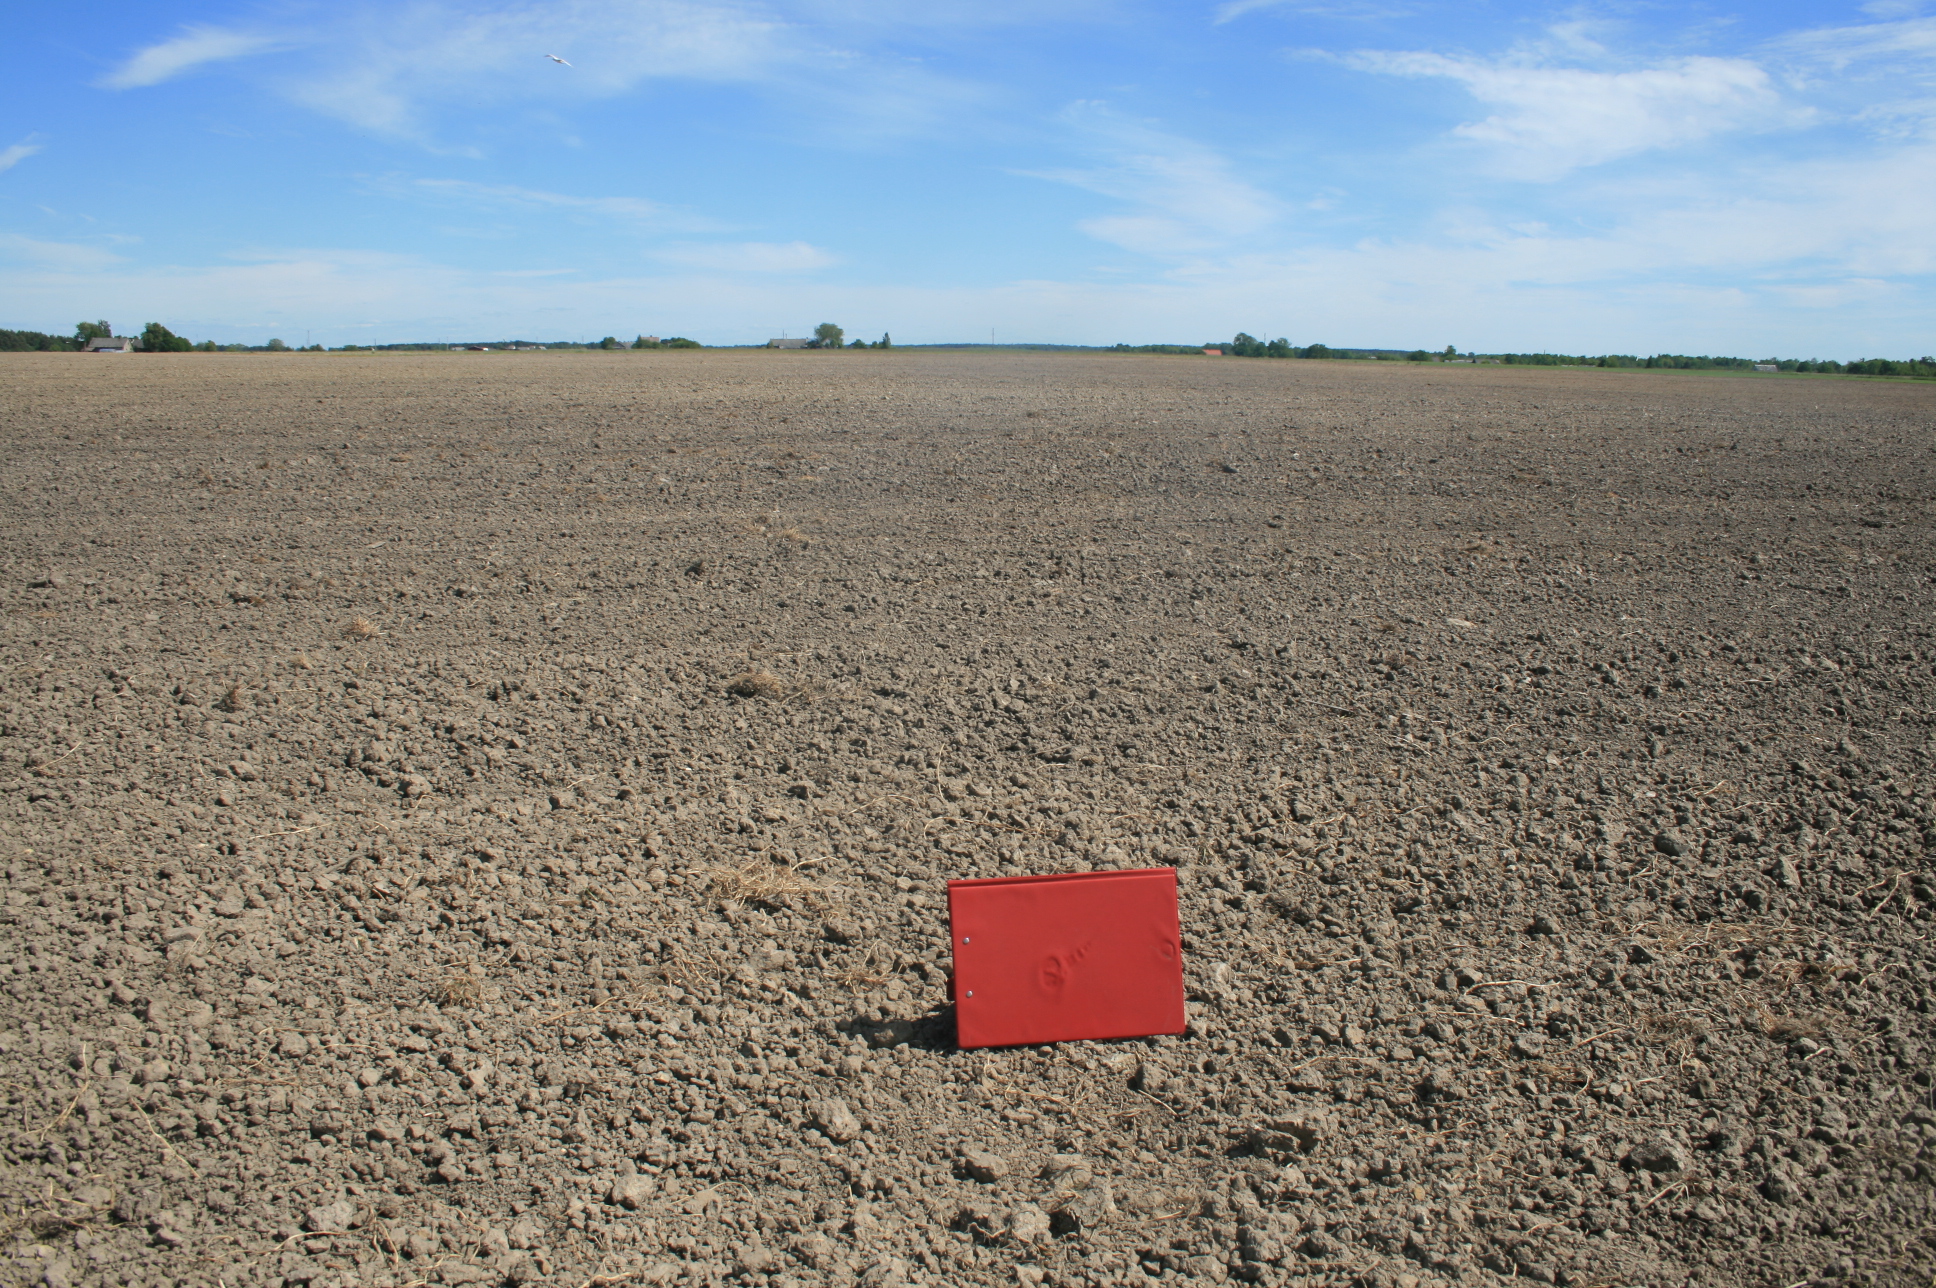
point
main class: Cropland
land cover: Rye
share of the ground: < 10 %
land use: Agriculture (excluding fallow land and kitchen gardens)
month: June
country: LT
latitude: 55.9302
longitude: 21.4235
